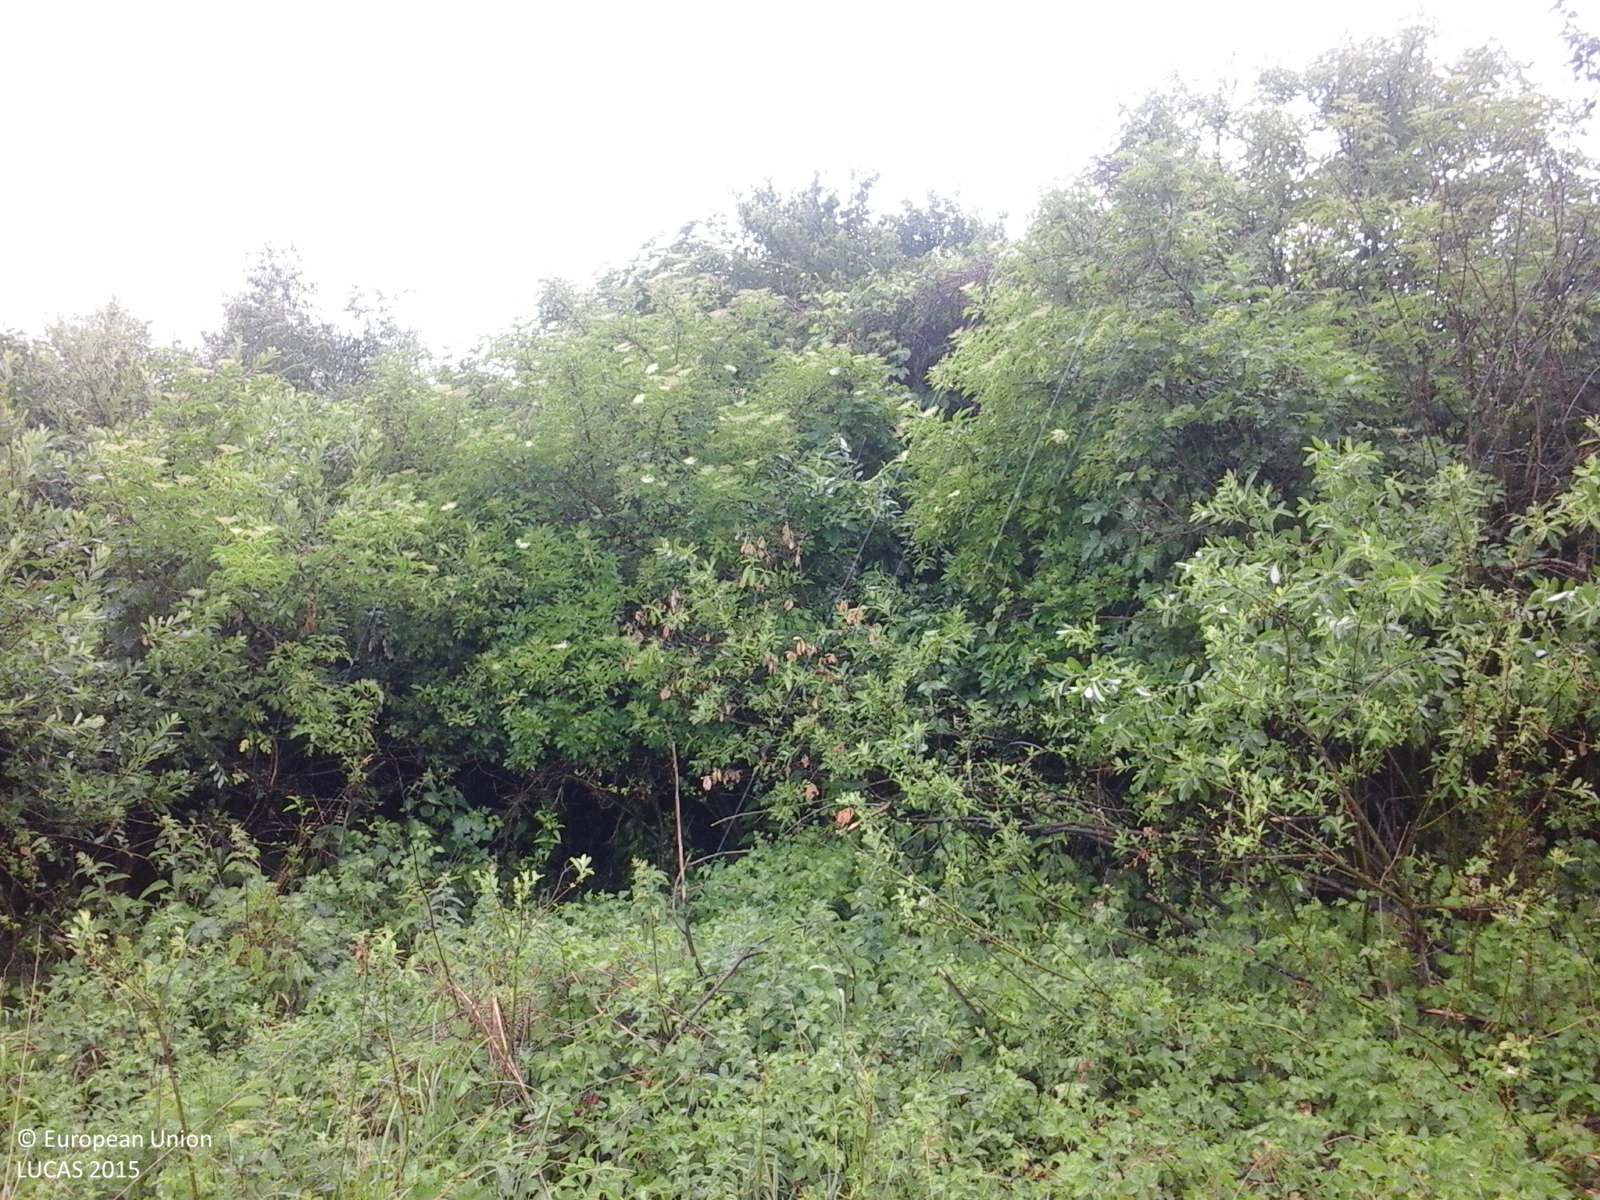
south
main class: Grassland
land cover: Grassland without tree/shrub cover
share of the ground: > 75 %
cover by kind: herbaceous plants 100 %
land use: Agriculture (excluding fallow land and kitchen gardens)
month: June
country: RO
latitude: 47.4361
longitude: 26.3262
